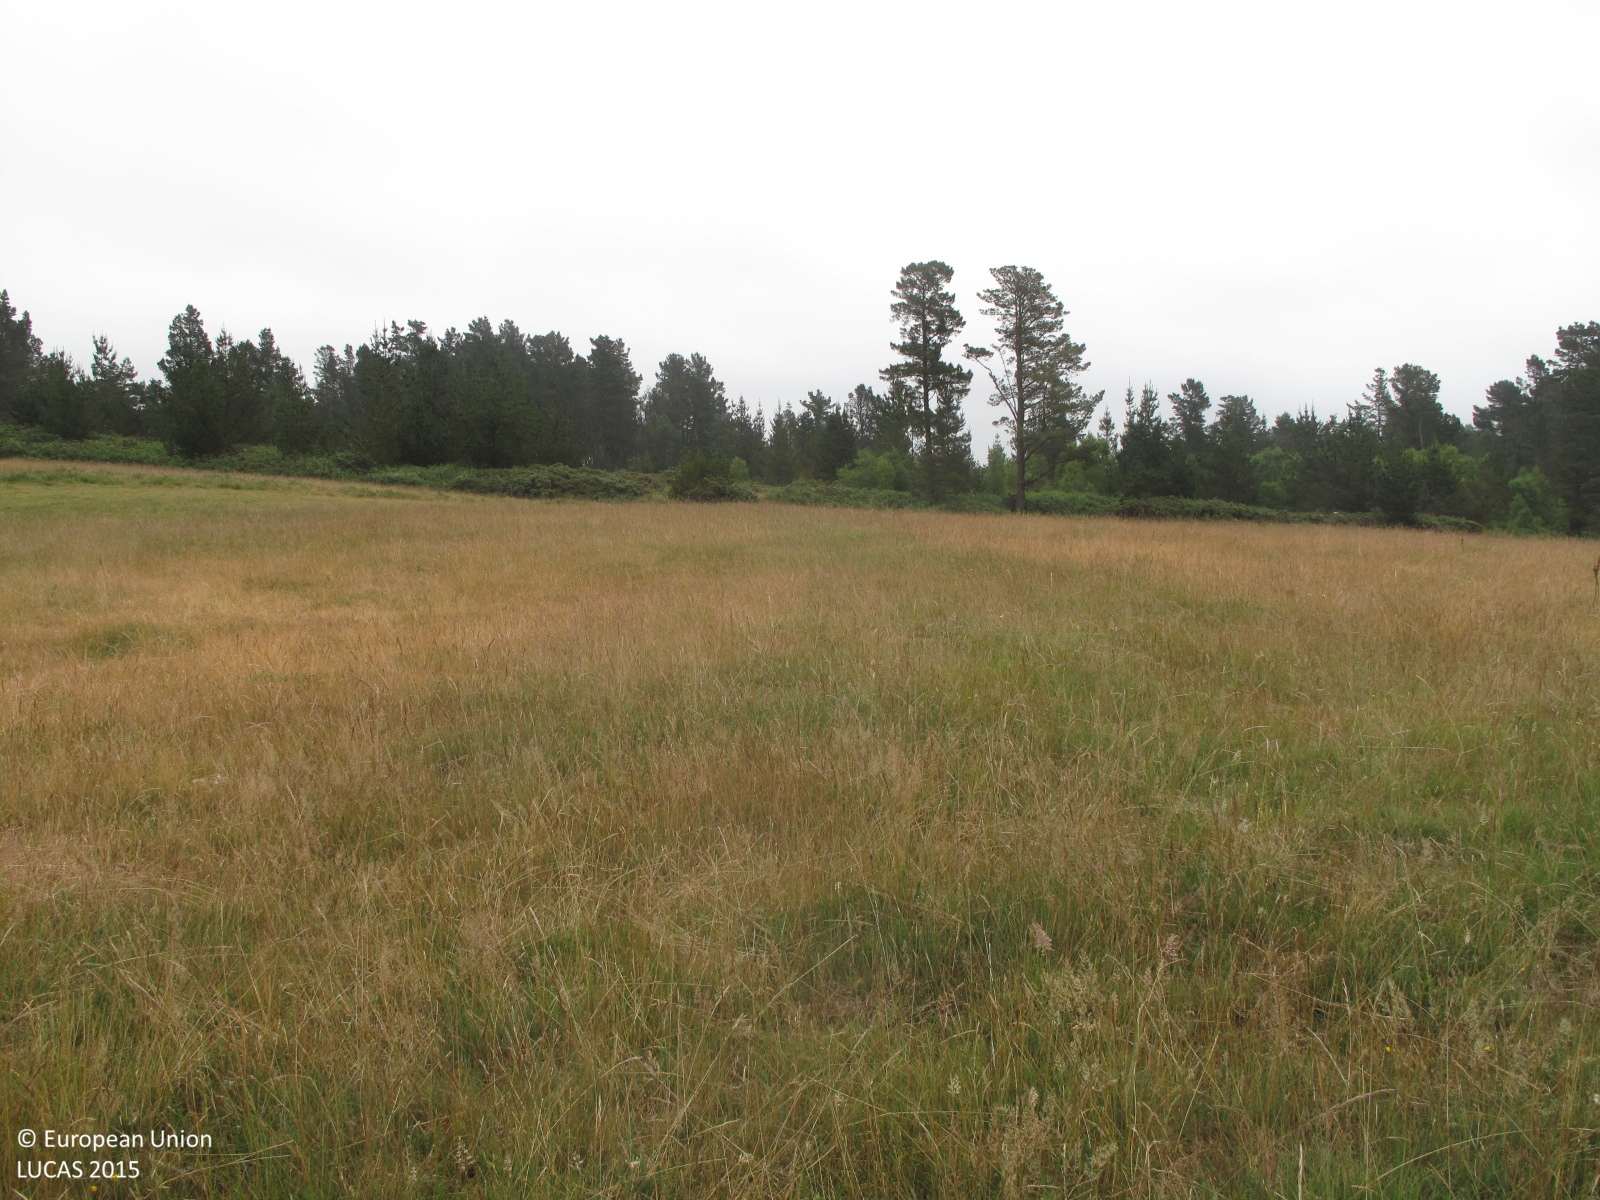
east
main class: Shrubland
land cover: Shrubland without tree cover
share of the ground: 10 - 25 %
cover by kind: herbaceous plants 90 %, shrubs 10 %
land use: Agriculture (excluding fallow land and kitchen gardens)
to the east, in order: Shrubland without tree cover; Shrubland with sparse tree cover; Rock outcrops; Shrubland with sparse tree cover; Tracks; Shrubland with sparse tree cover; Pine dominated coniferous woodland; Tracks; Other mixed woodland
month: June
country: ES
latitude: 43.1860
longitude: -8.0957
